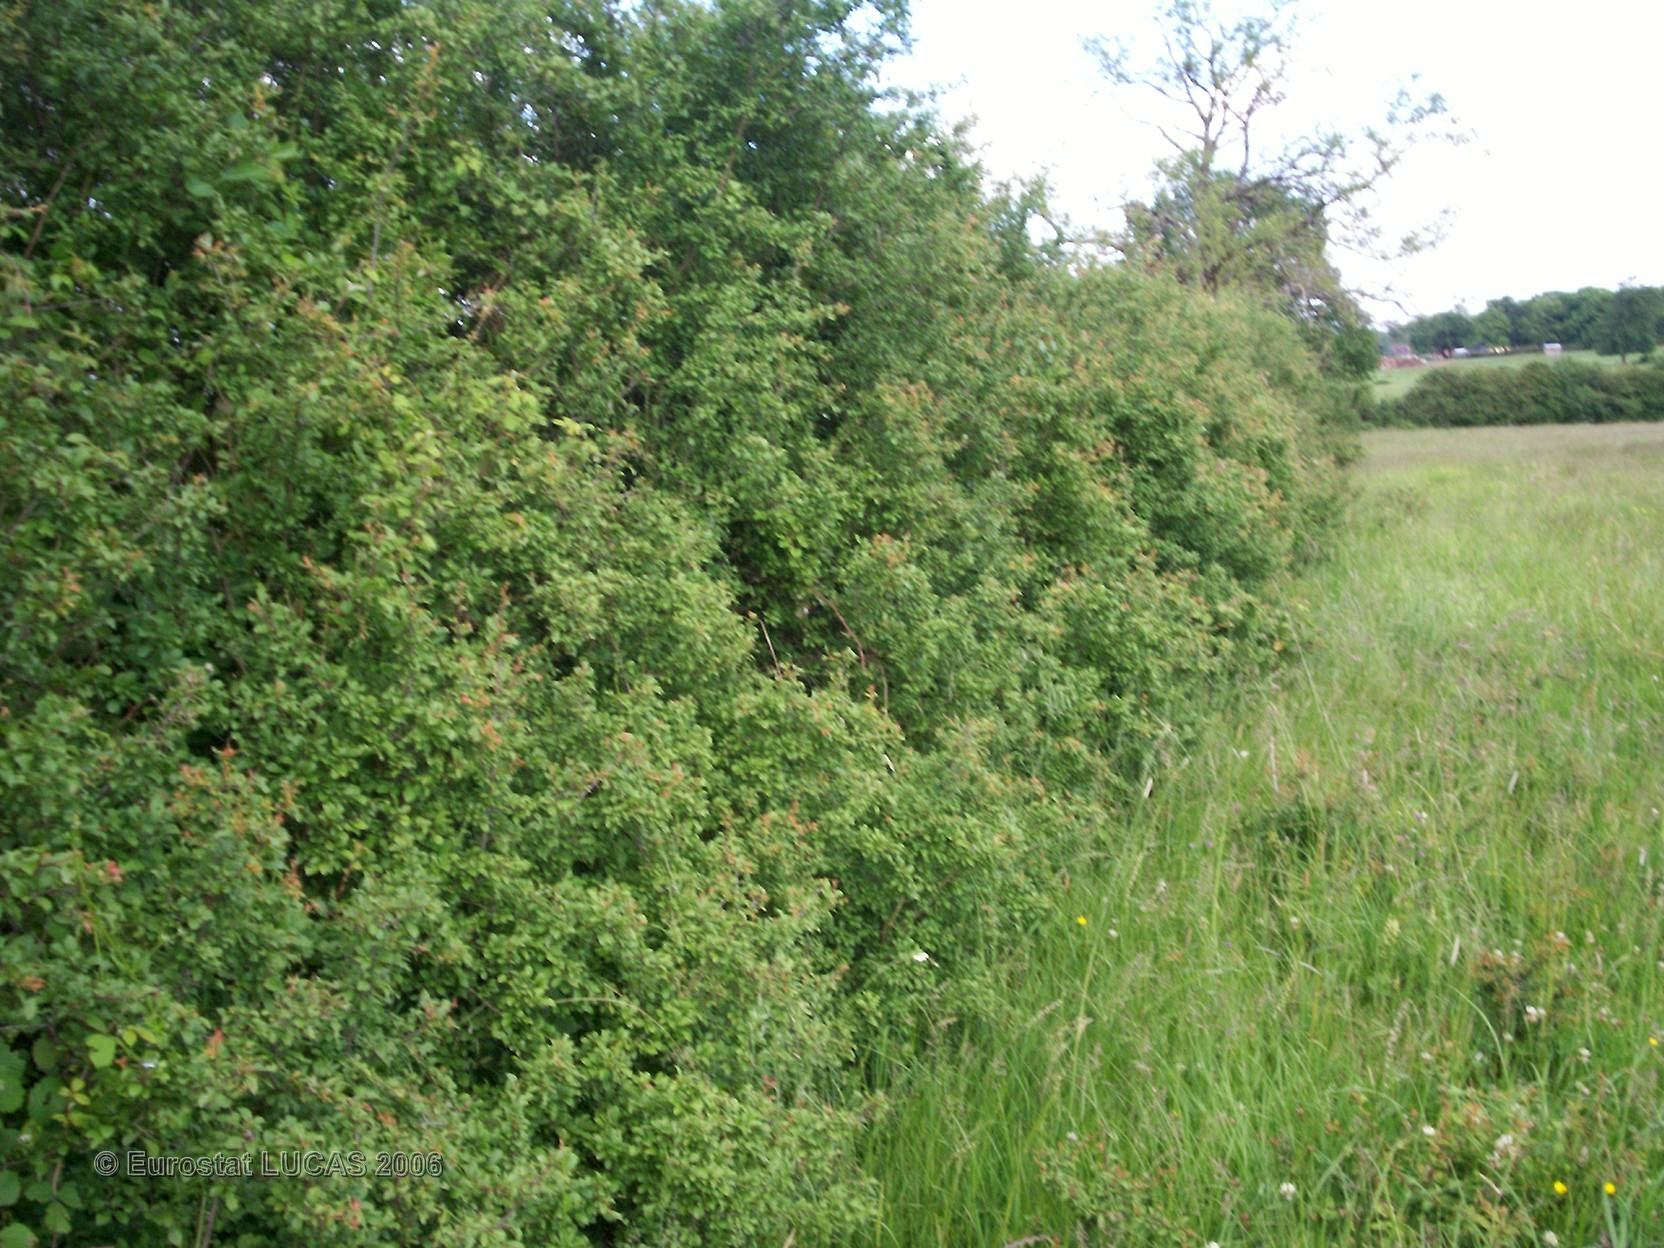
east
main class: Grassland
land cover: Grassland without tree/shrub cover
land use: Agriculture (excluding fallow land and kitchen gardens)
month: June
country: FR
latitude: 47.0439
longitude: 3.0066
